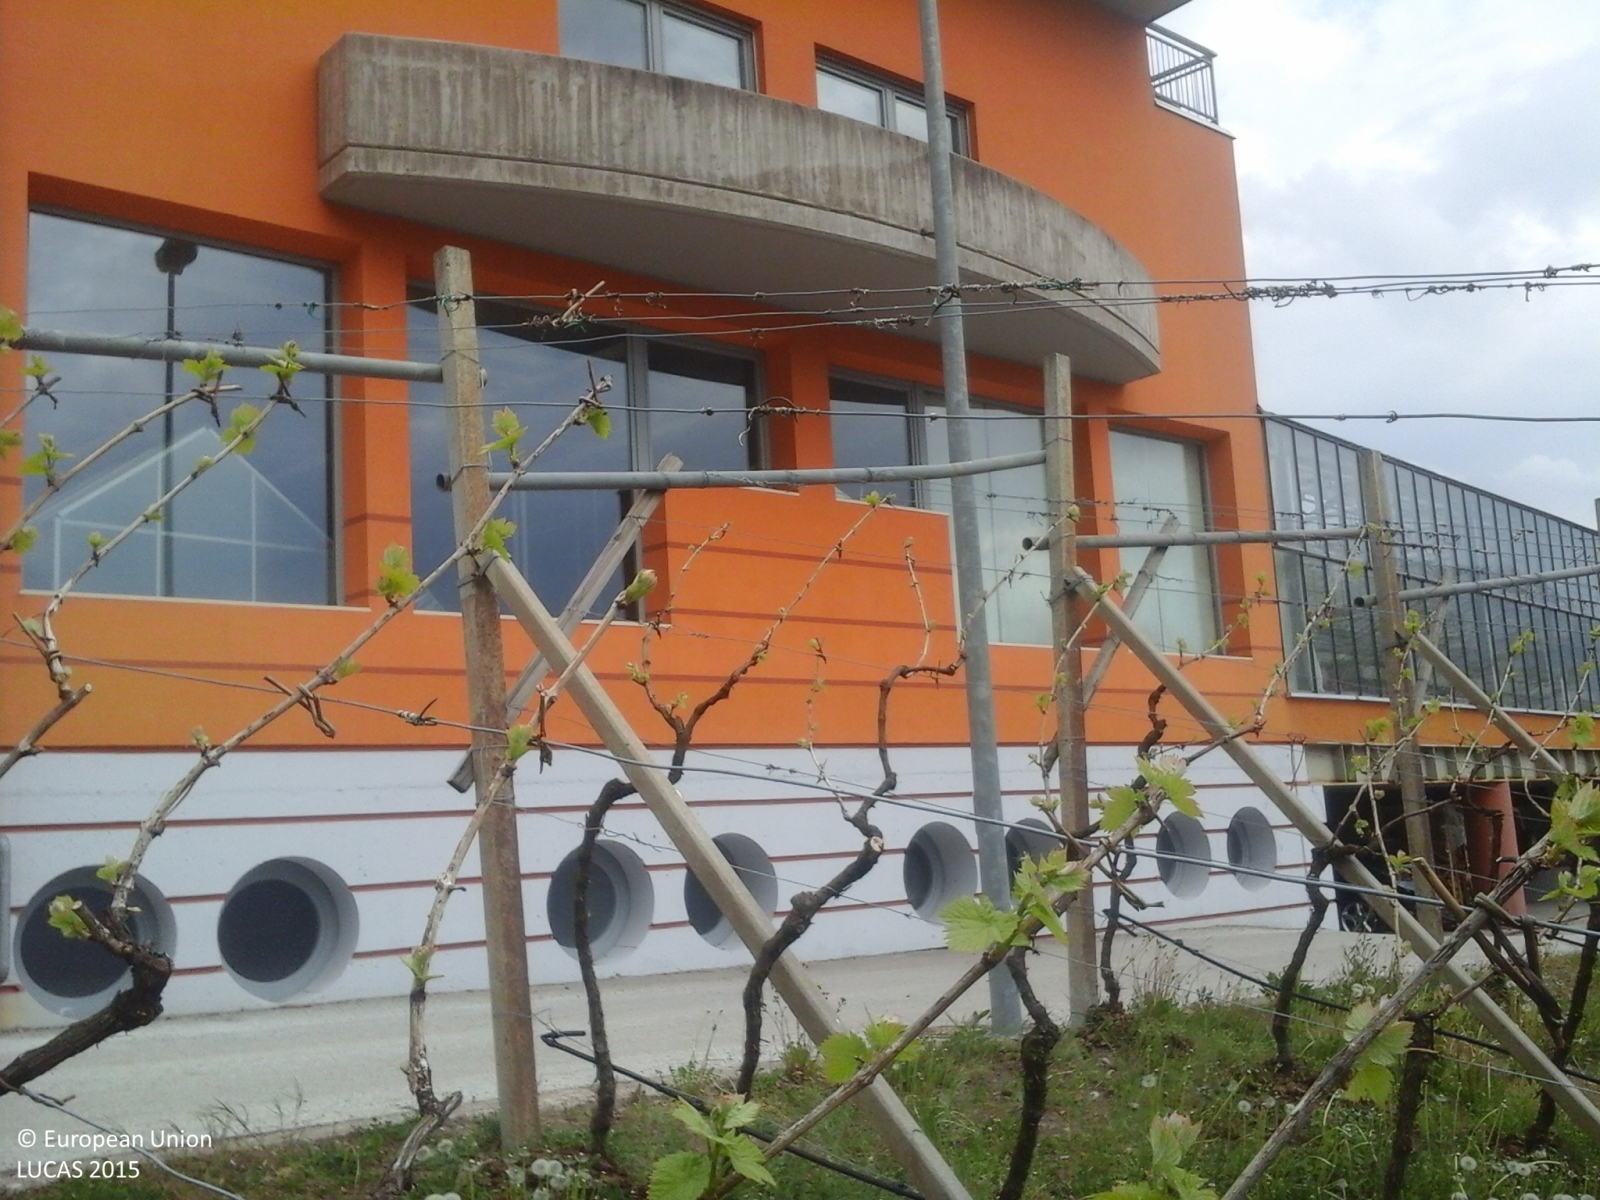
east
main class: Cropland
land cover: Vineyards
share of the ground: < 10 %
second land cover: Grassland without tree/shrub cover
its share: > 75 %
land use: Agriculture (excluding fallow land and kitchen gardens)
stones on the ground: < 10 %
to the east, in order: Vineyards; Grassland without tree/shrub cover; Artificial constructions in urban areas; Broadleaved woodland
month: April
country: IT
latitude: 46.1643
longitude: 11.2028
